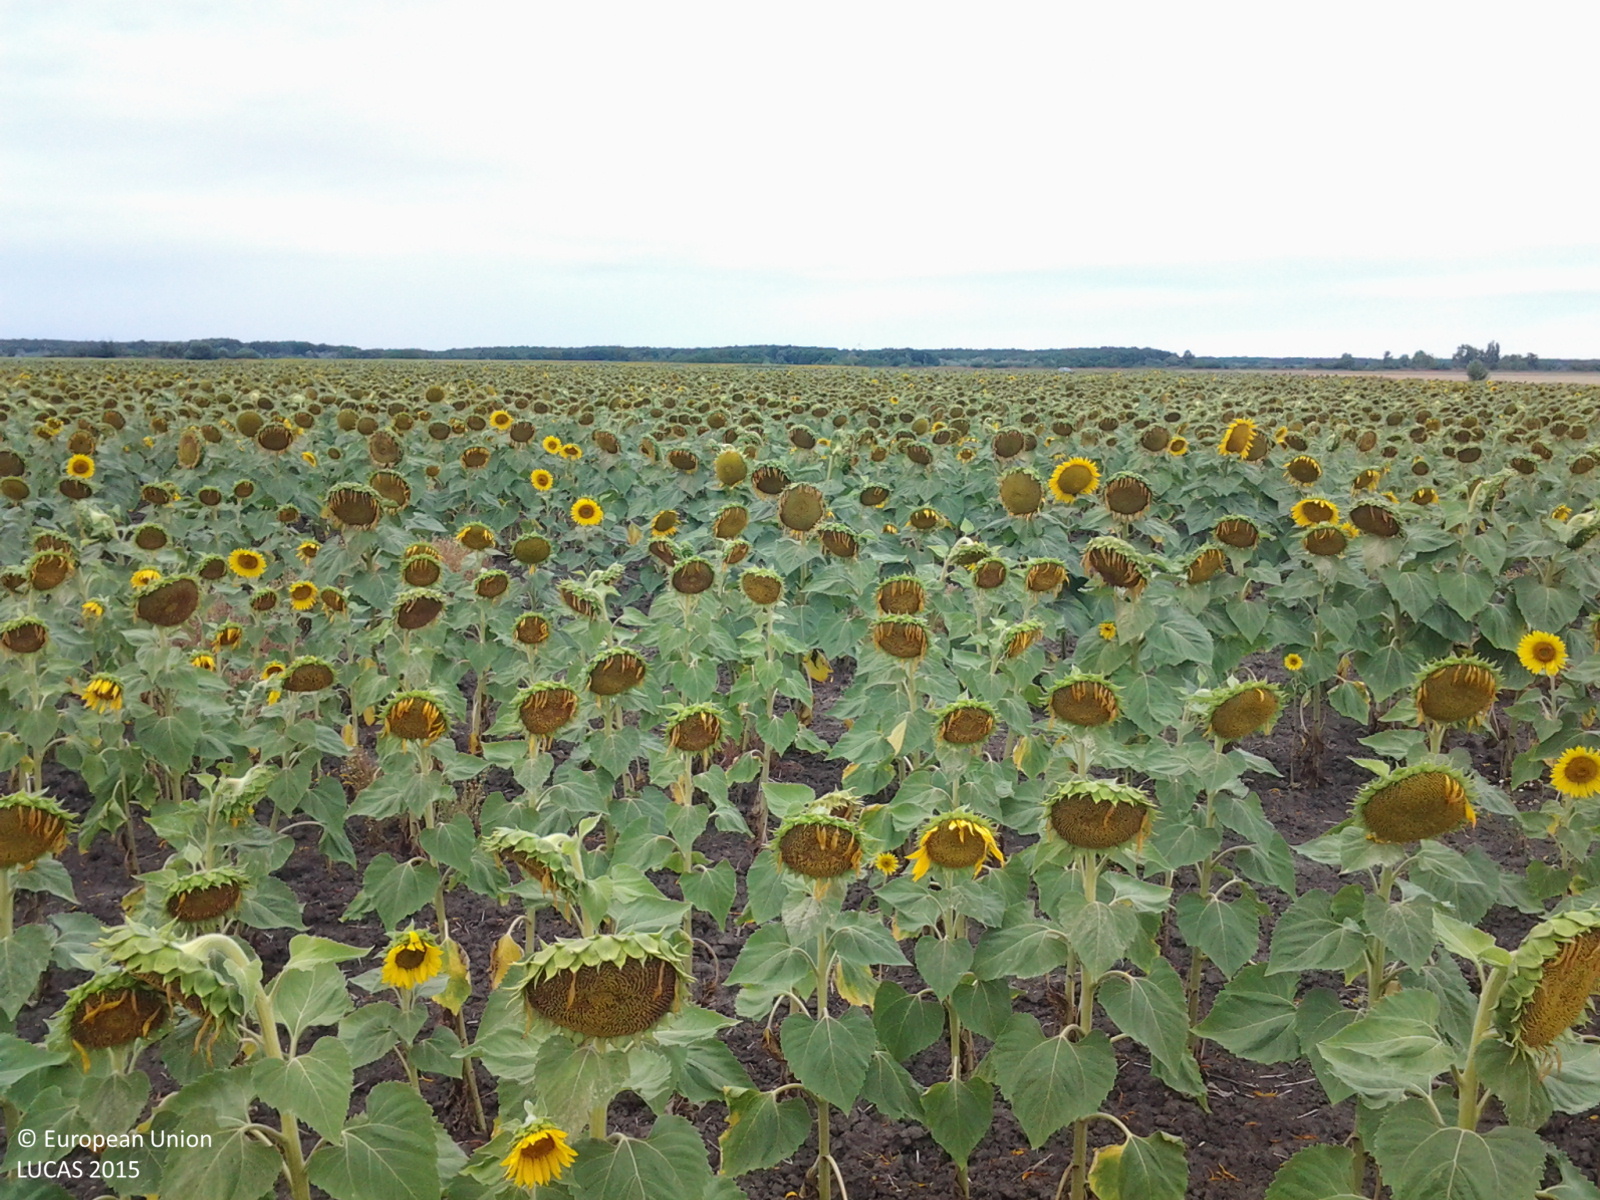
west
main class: Cropland
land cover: Sunflower
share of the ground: > 75 %
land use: Agriculture (excluding fallow land and kitchen gardens)
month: July
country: HU
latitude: 47.1363
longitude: 20.5380
